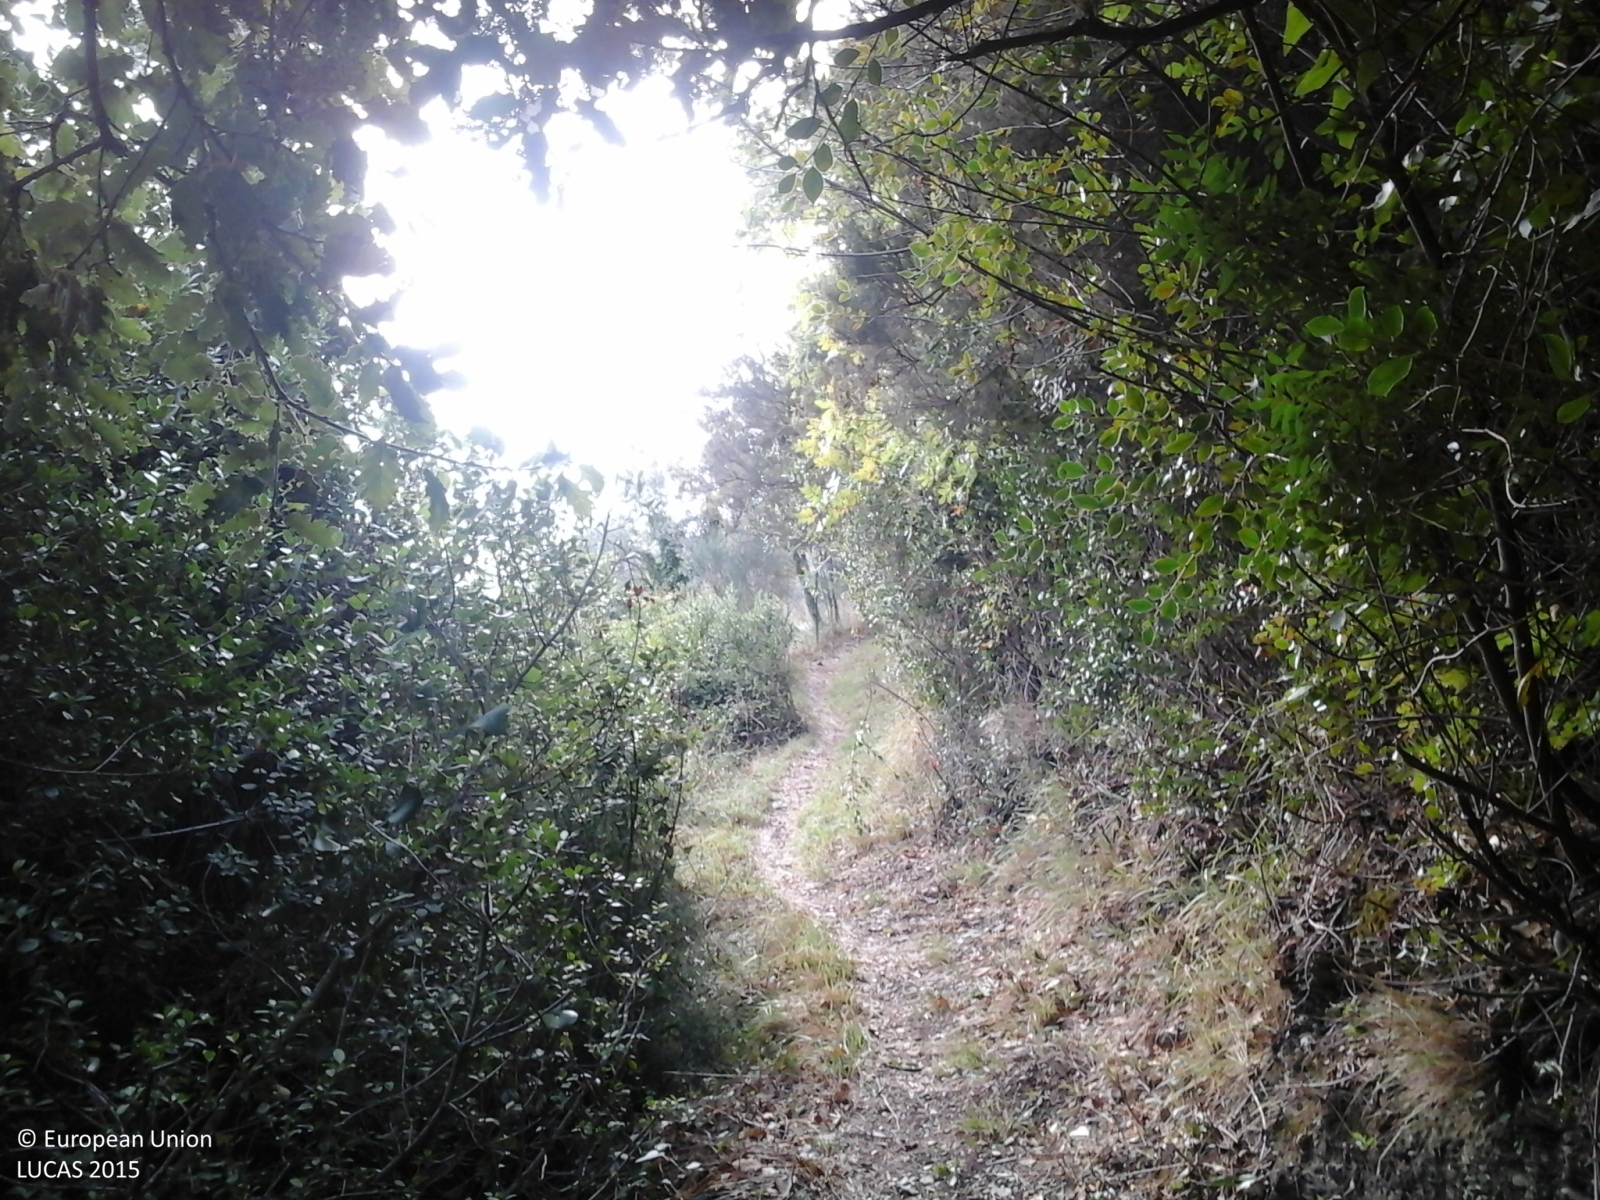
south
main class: Woodland
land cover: Other mixed woodland
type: broadleaved evergreen forest
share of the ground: > 75 %
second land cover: Shrubland without tree cover
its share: 10 - 25 %
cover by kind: broadleaved forest trees 50 %, coniferous forest trees 20 %, shrubs 20 %, herbaceous plants 10 %
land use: Semi-natural and natural areas not in use
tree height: > 5 m
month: October
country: IT
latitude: 44.0092
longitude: 8.1460
